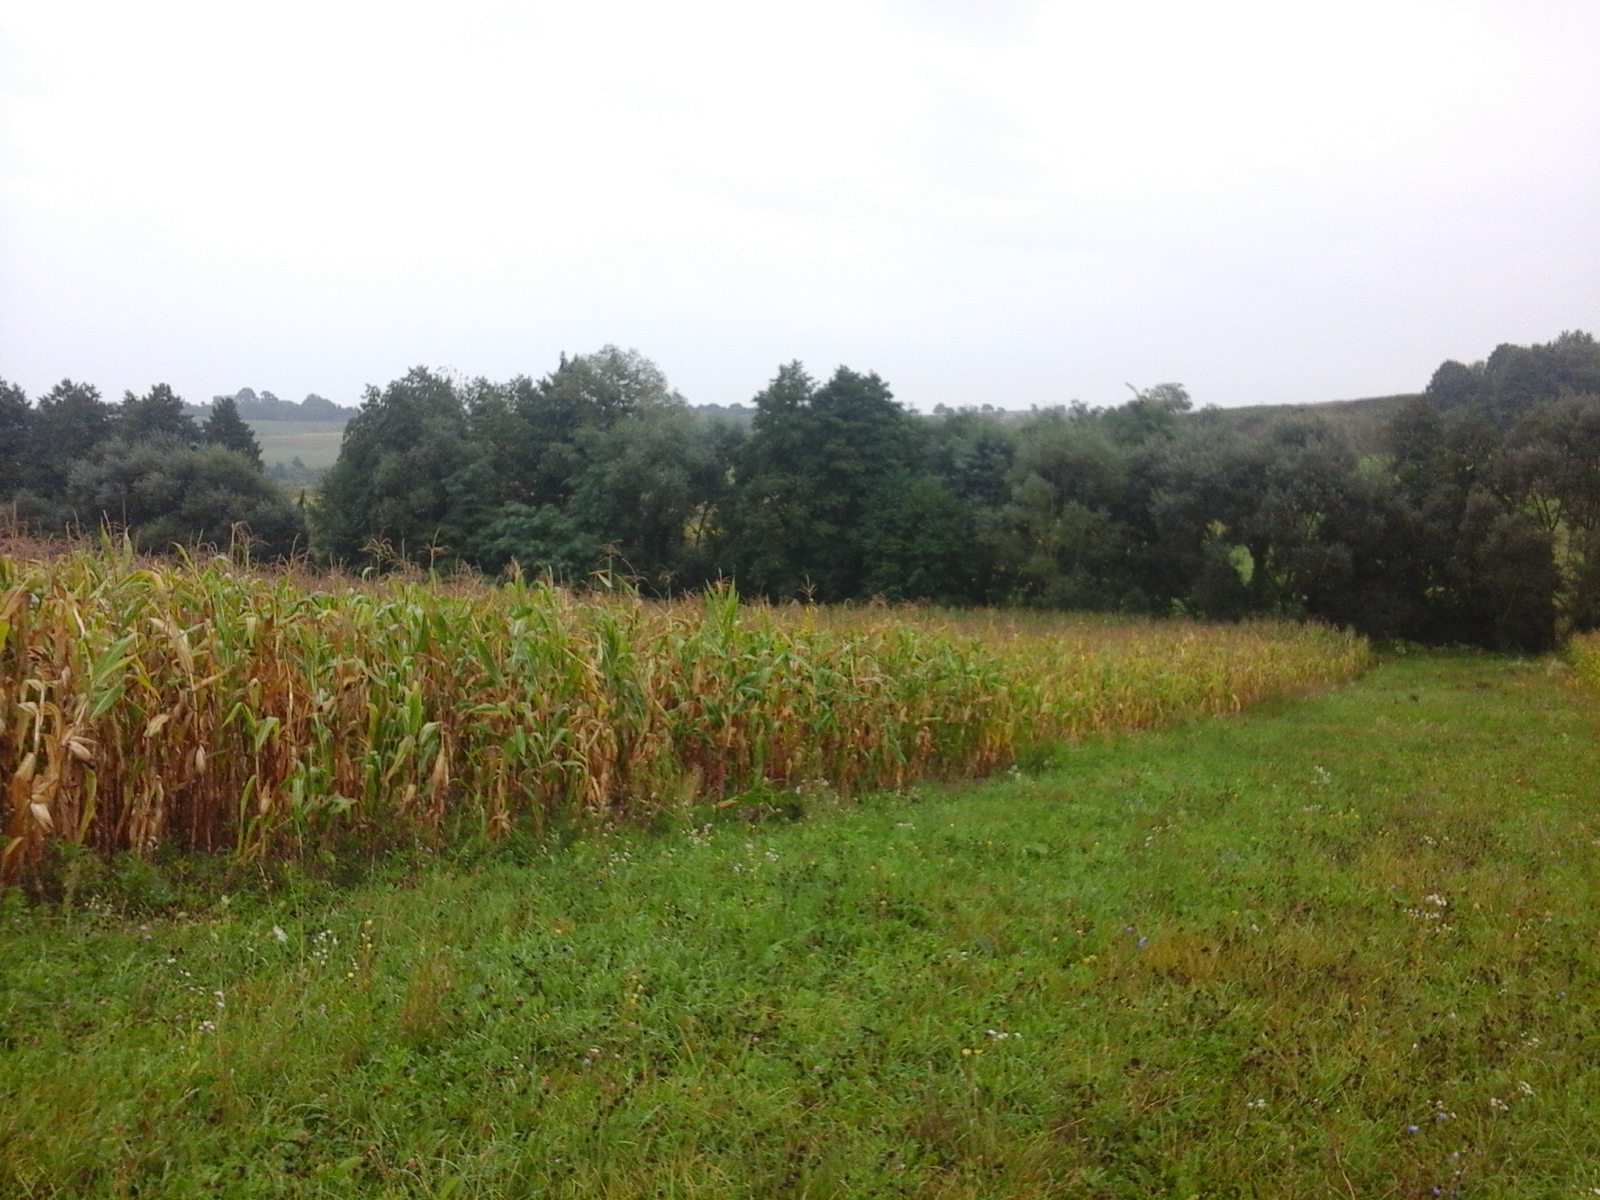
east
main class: Cropland
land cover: Other leguminous and mixtures for fodder
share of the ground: > 75 %
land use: Agriculture (excluding fallow land and kitchen gardens)
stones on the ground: < 10 %
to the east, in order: Other leguminous and mixtures for fodder; Maize; Abandoned hedges; Rivers and streams; Abandoned hedges; Grassland without tree/shrub cover; Arable land (only in case pi)
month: September
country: RO
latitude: 47.1897
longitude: 22.5813
